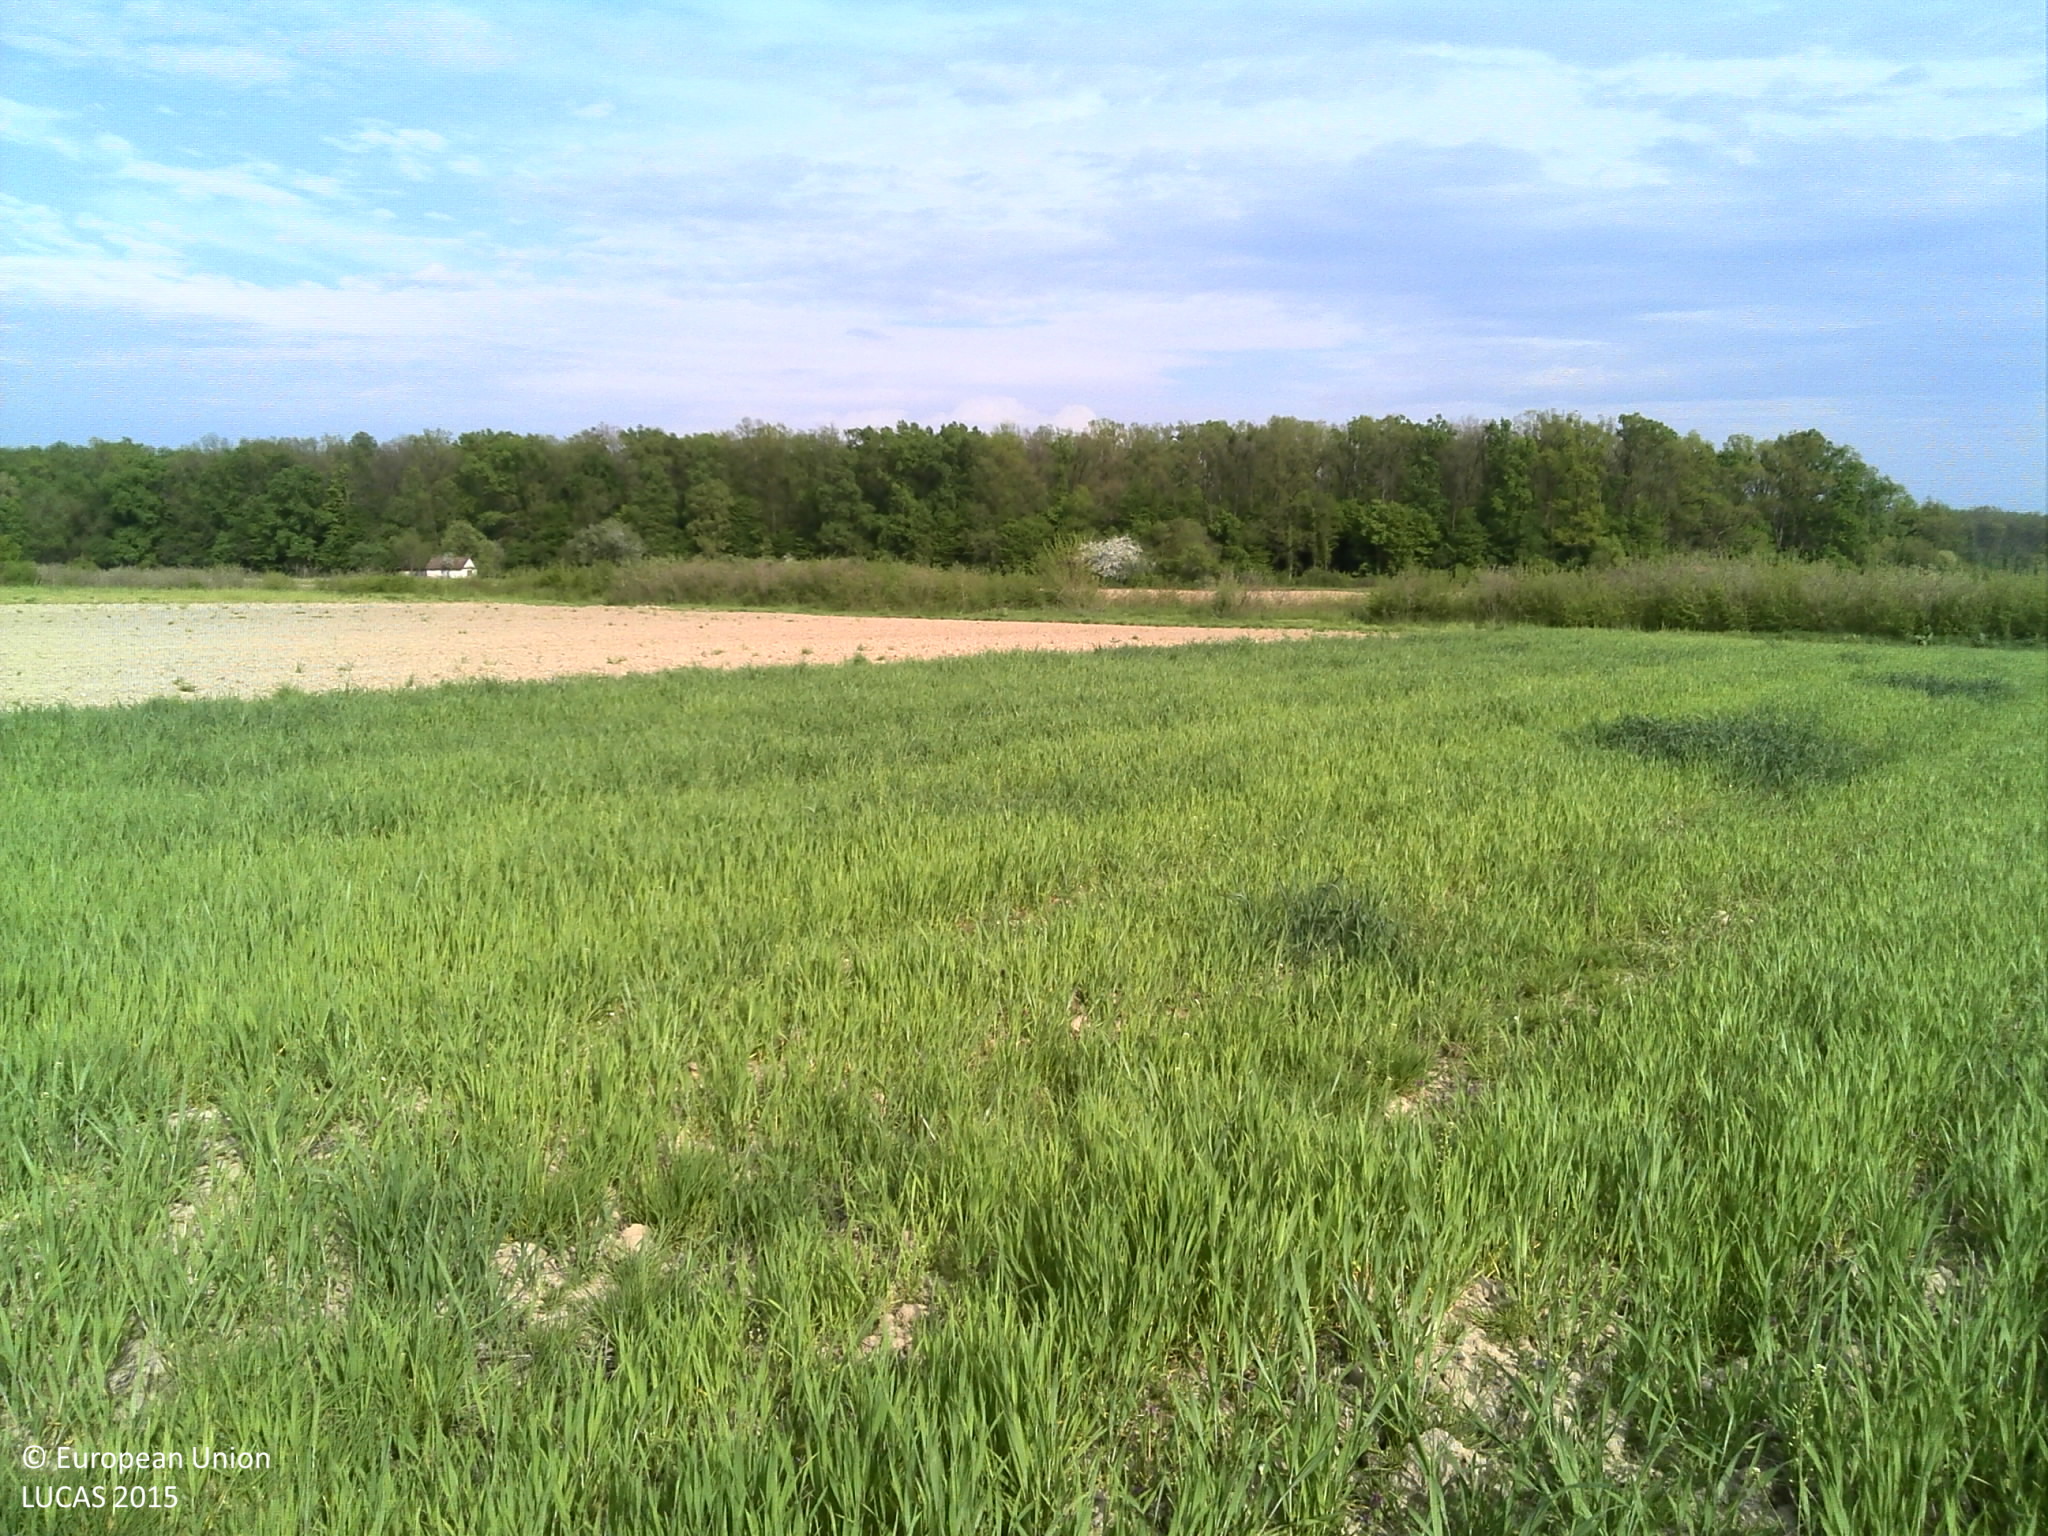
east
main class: Cropland
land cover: Common wheat
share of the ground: > 75 %
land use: Agriculture (excluding fallow land and kitchen gardens)
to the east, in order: Common wheat; Other bare soil; Tracks; Ditches and canals; Other bare soil
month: April
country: HR
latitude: 45.0633
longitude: 18.8072
